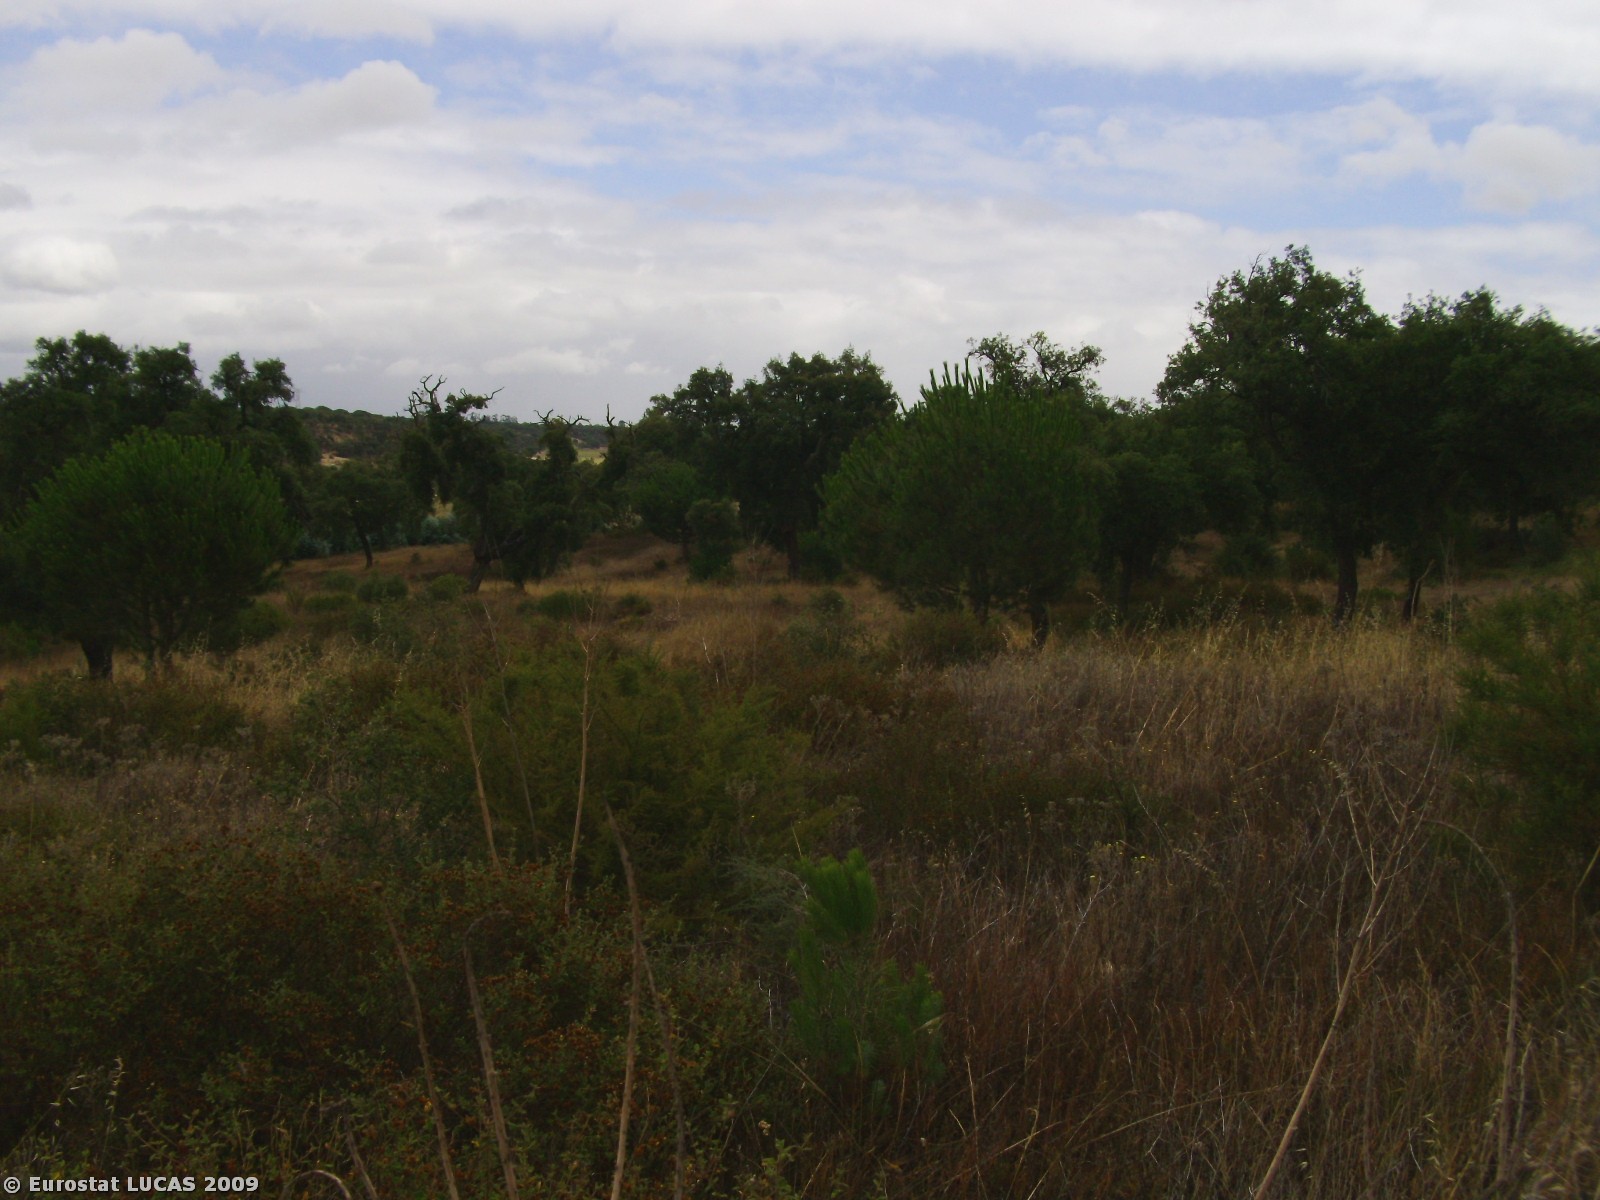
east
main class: Grassland
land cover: Spontaneously vegetated surfaces
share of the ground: > 75 %
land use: Fallow land
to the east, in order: Spontaneously vegetated surfaces; Broadleaved woodland; Fences; Bare land
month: July
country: PT
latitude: 38.9373
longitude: -8.7698
